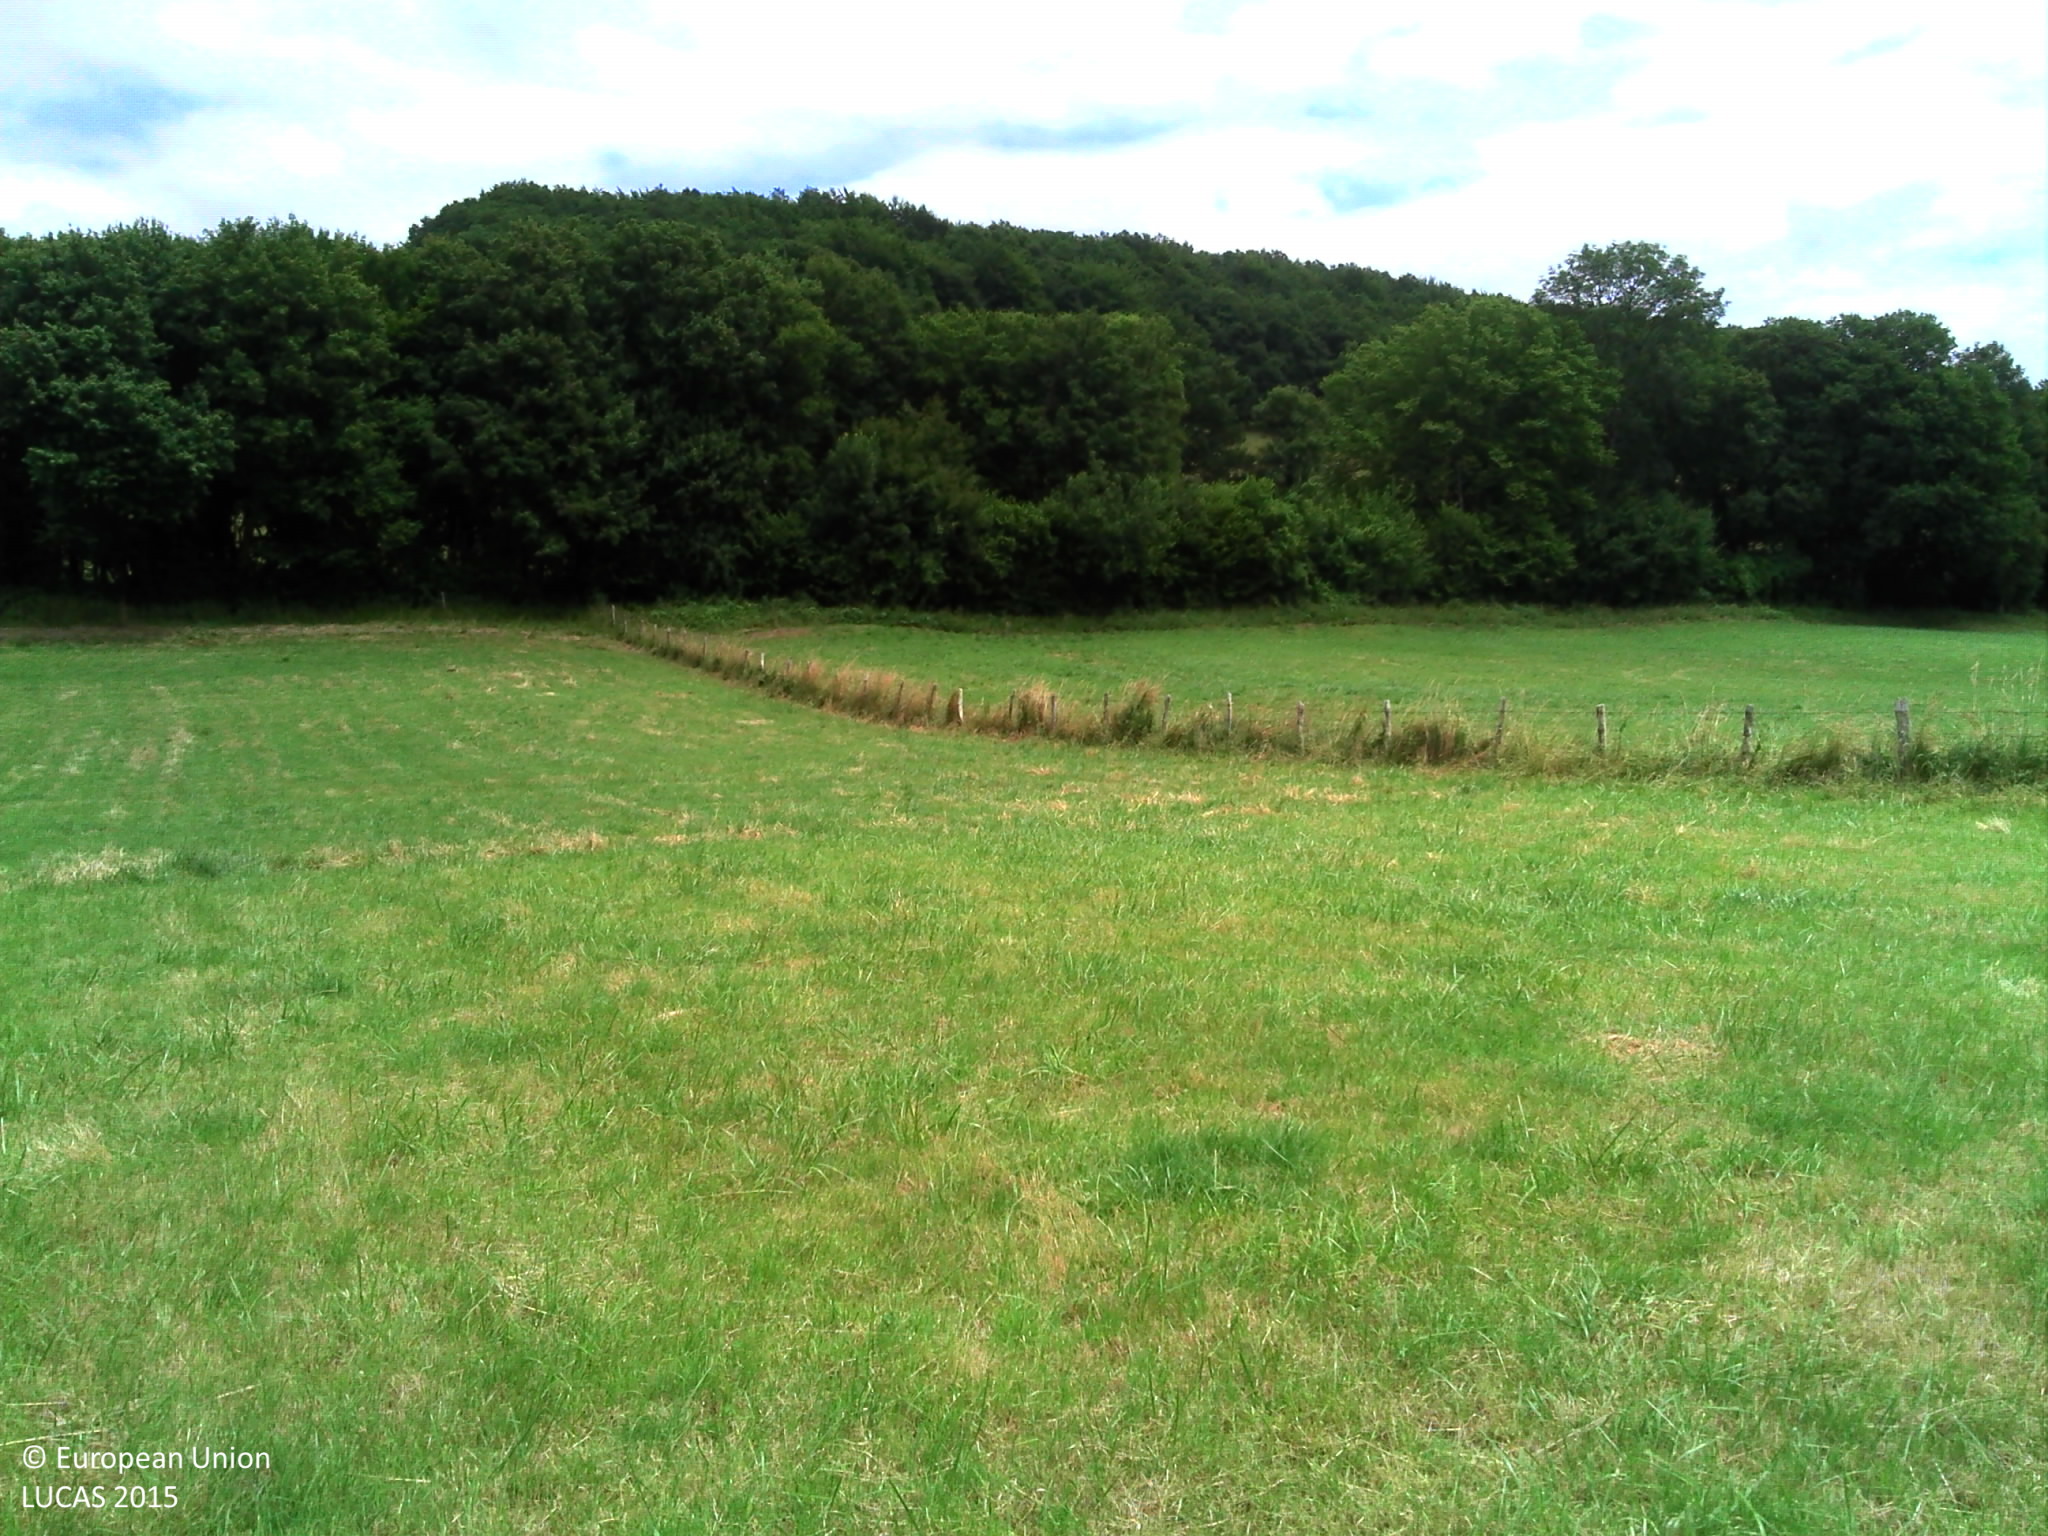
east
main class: Grassland
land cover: Grassland without tree/shrub cover
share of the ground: > 75 %
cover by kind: herbaceous plants 100 %
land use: Agriculture (excluding fallow land and kitchen gardens)
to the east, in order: Grassland without tree/shrub cover; Fences; Grassland without tree/shrub cover; Fences; Broadleaved woodland; Fences; Grassland without tree/shrub cover
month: June
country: FR
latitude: 47.3277
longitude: 3.2075
